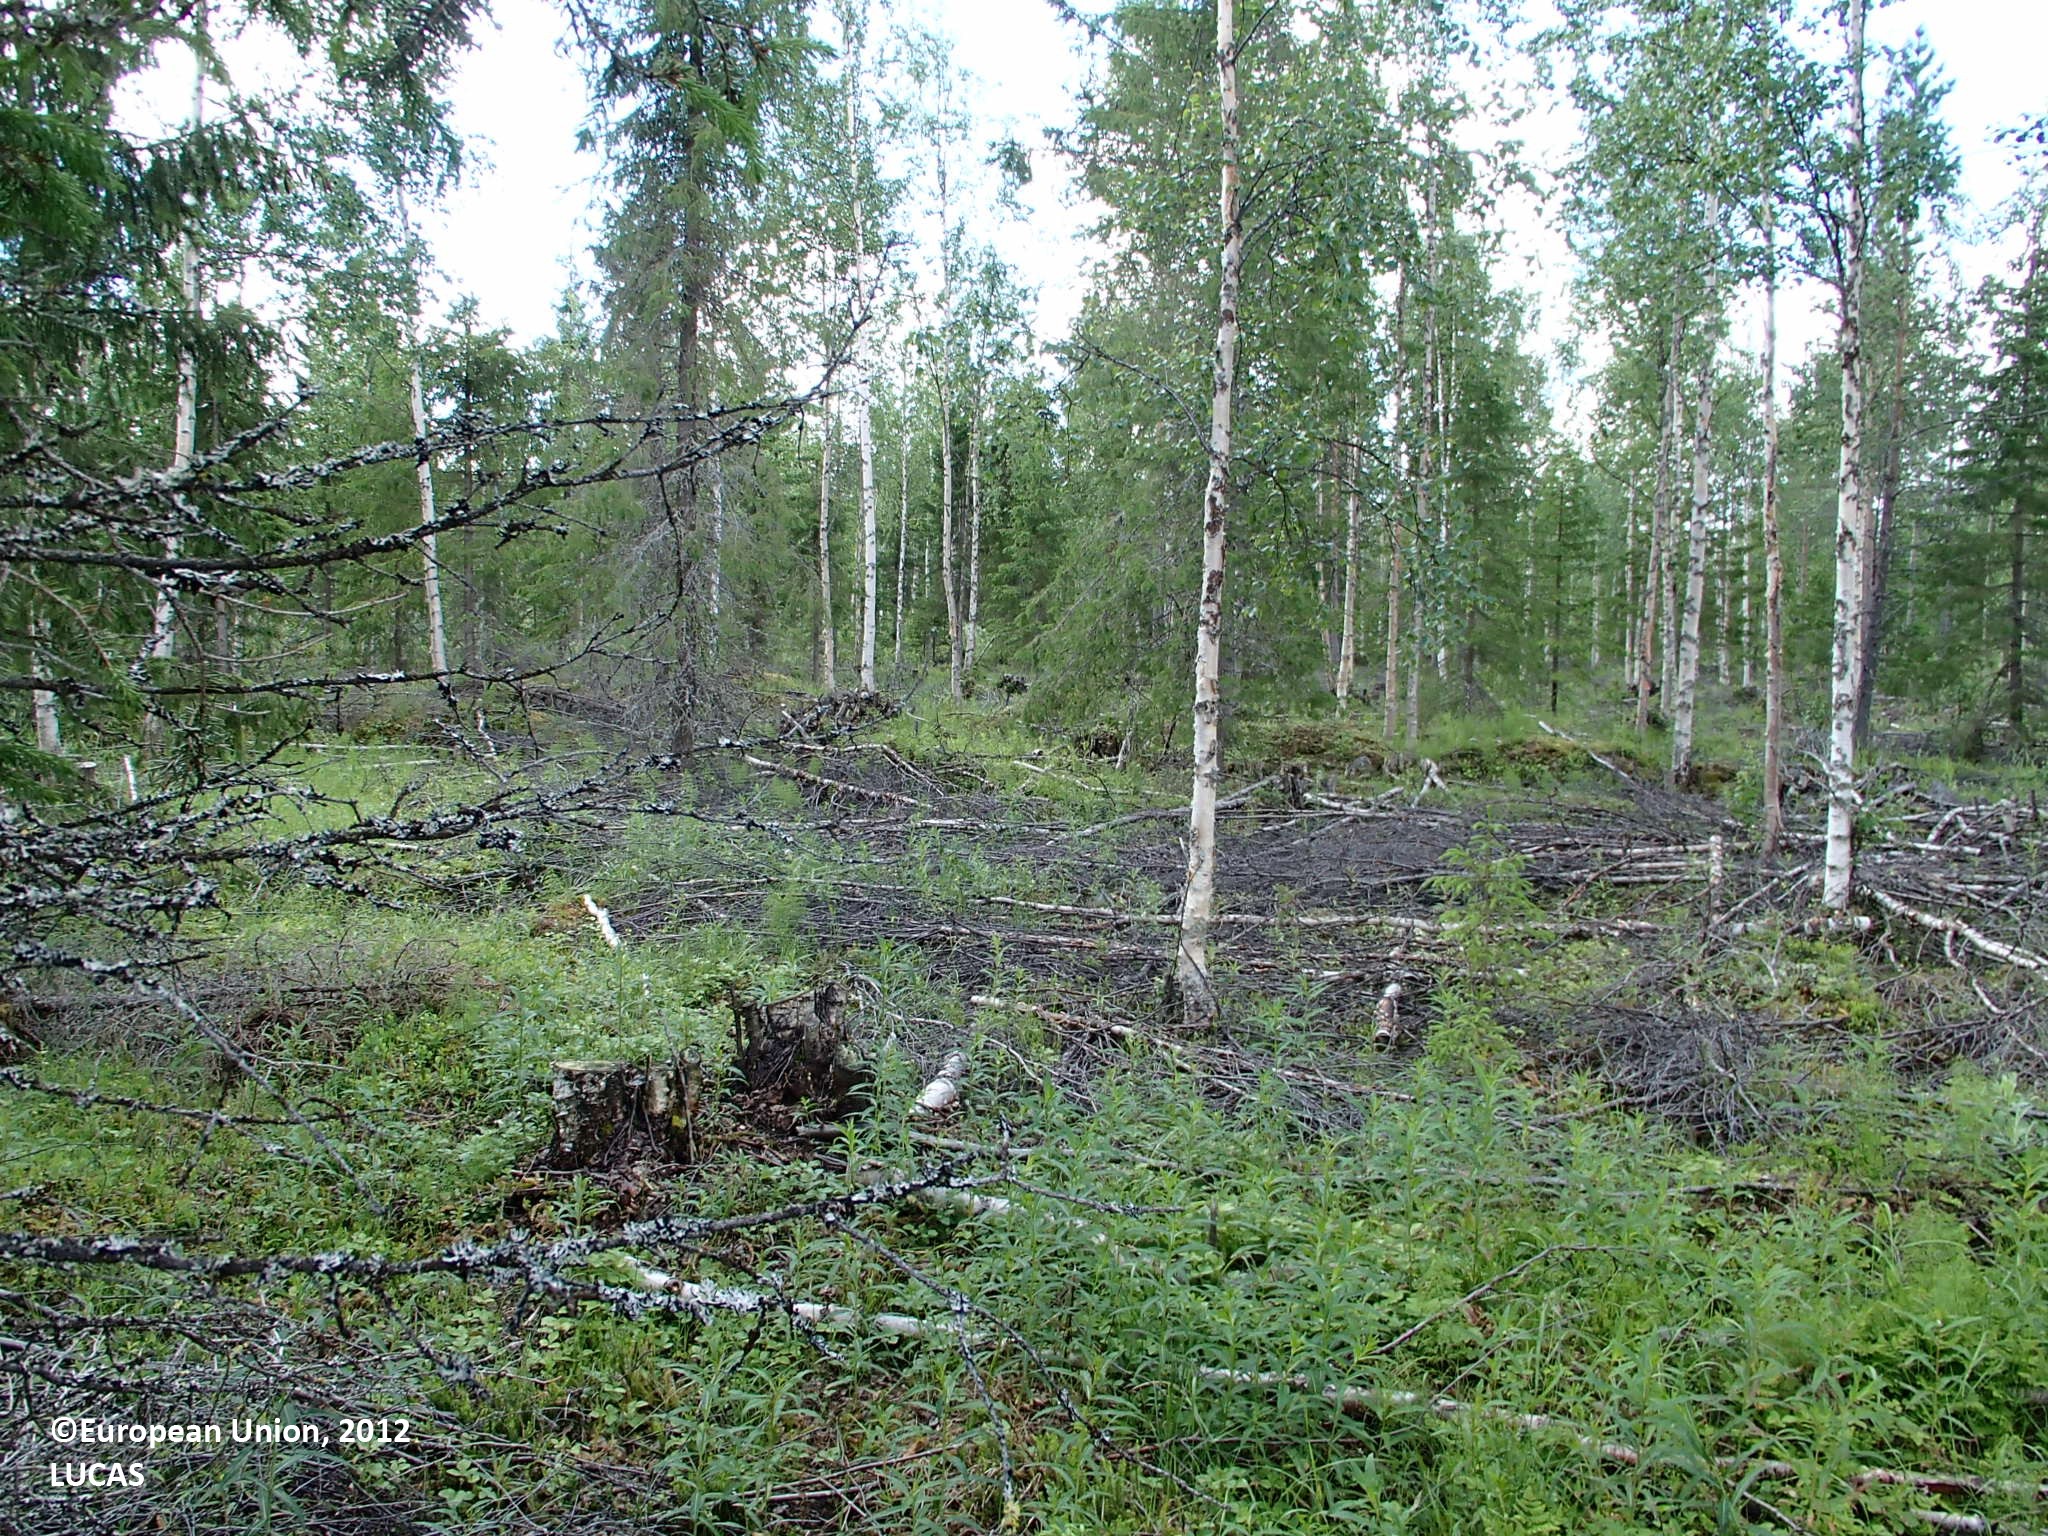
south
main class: Woodland
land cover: Other mixed woodland
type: boreal forest
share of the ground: > 75 %
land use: Forestry
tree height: > 5 m
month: July
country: FI
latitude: 67.3467
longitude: 26.9535
